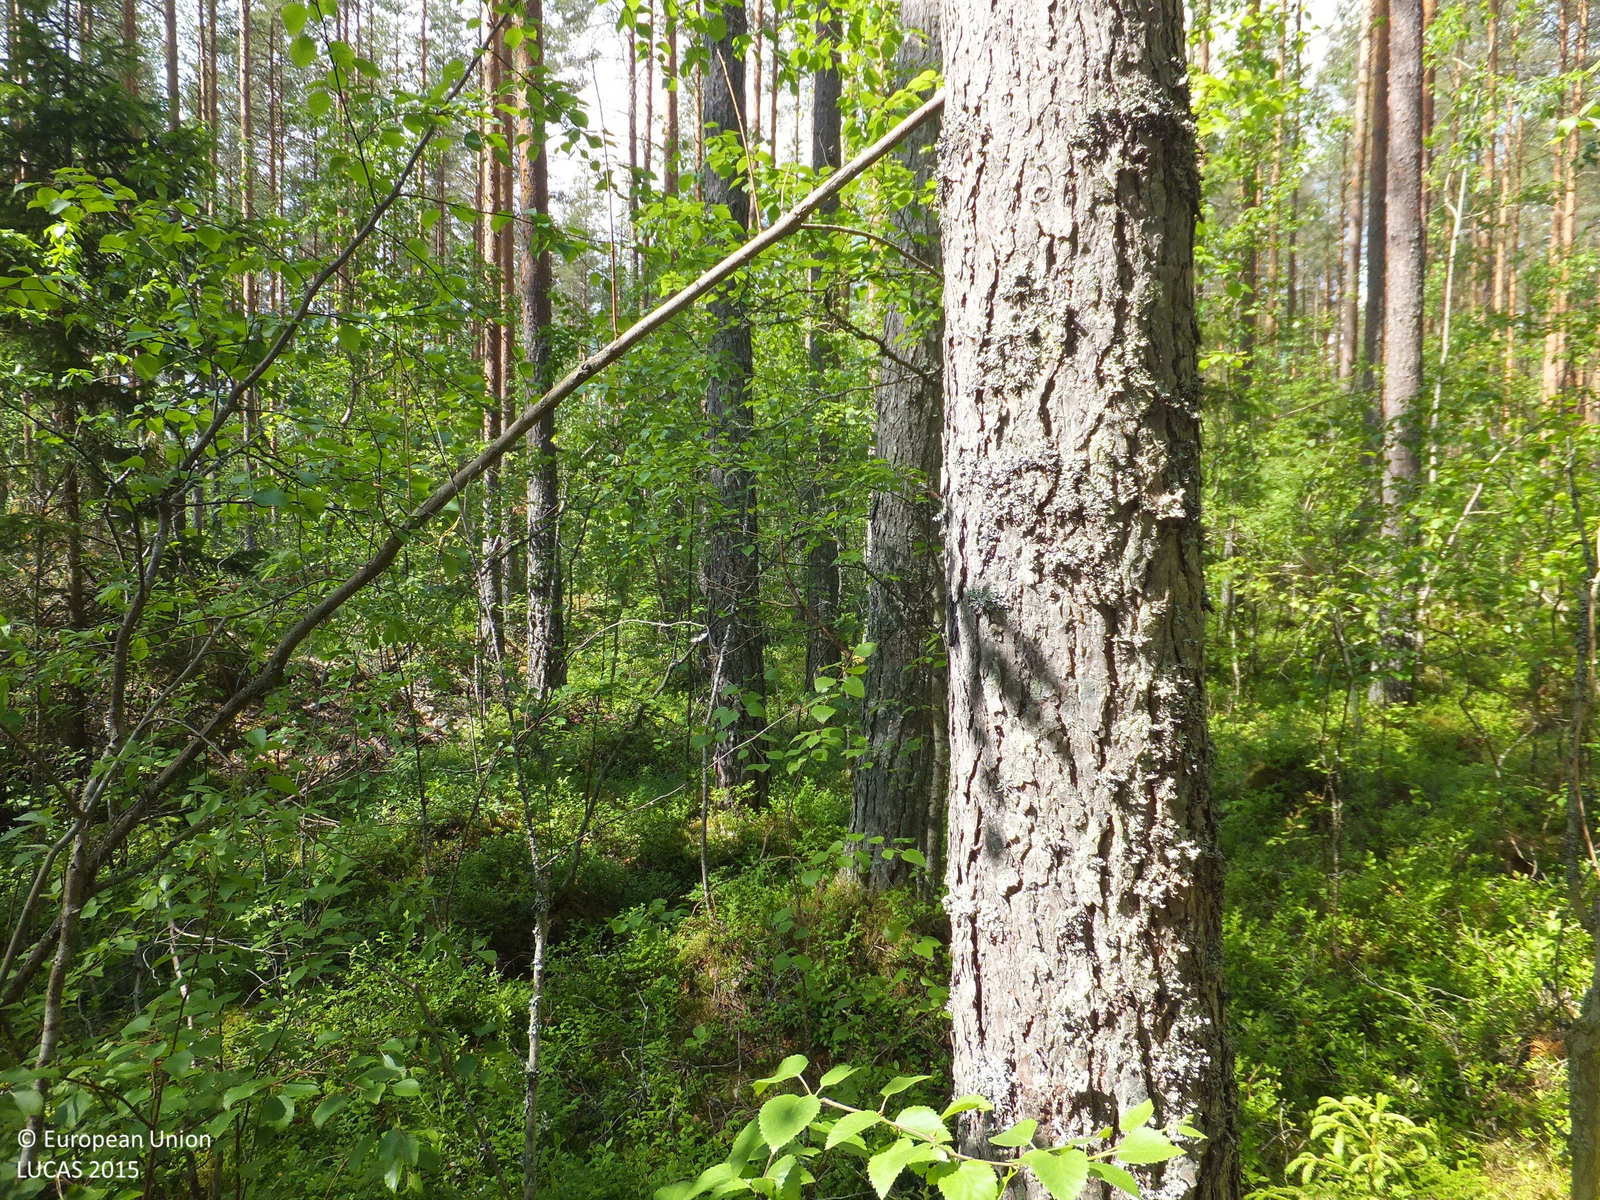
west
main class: Woodland
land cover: Pine dominated mixed woodland
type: boreal forest
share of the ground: 50 - 75 %
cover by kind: coniferous forest trees 35 %, broadleaved forest trees 25 %, shrubs 20 %, herbaceous plants 10 %, lichens and mosses 10 %
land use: Forestry
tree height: > 5 m
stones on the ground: 25 - 50 %
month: June
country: FI
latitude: 63.2024
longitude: 24.0105
